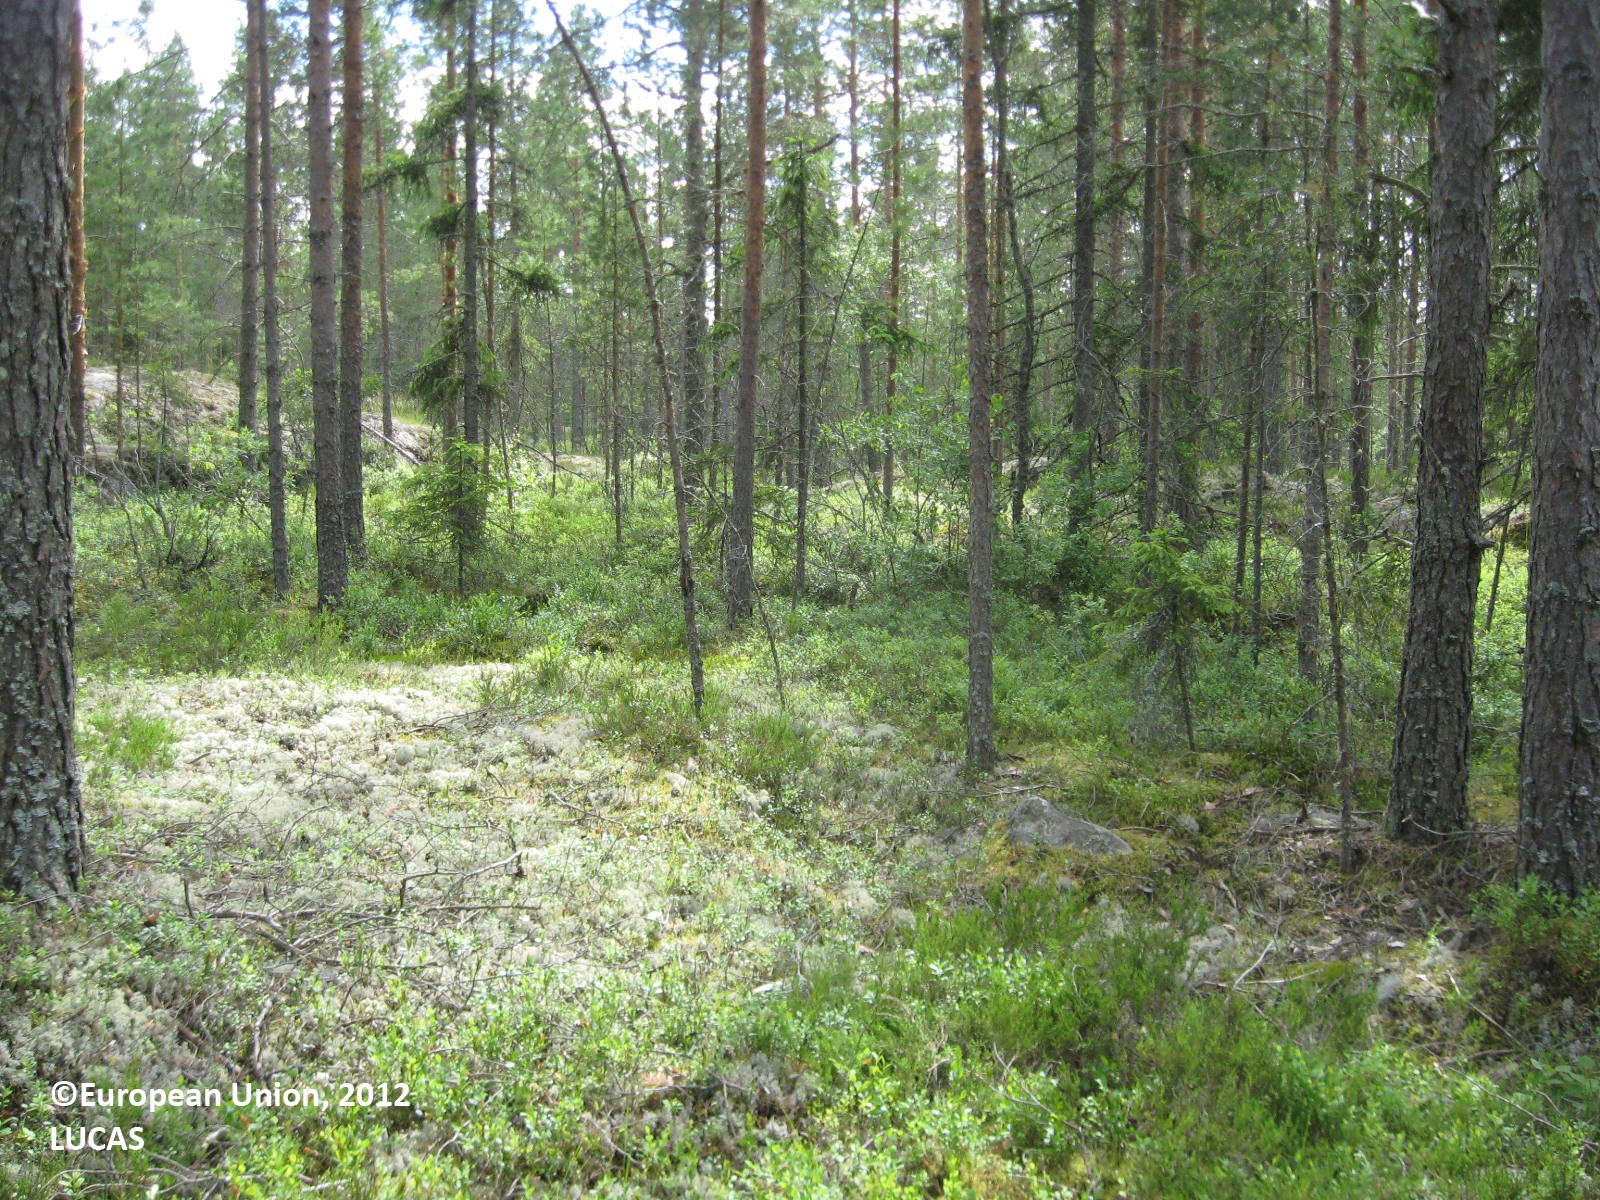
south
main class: Woodland
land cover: Pine dominated coniferous woodland
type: boreal forest
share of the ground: > 75 %
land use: Forestry
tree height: > 5 m
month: July
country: FI
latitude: 62.6897
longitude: 22.5387
